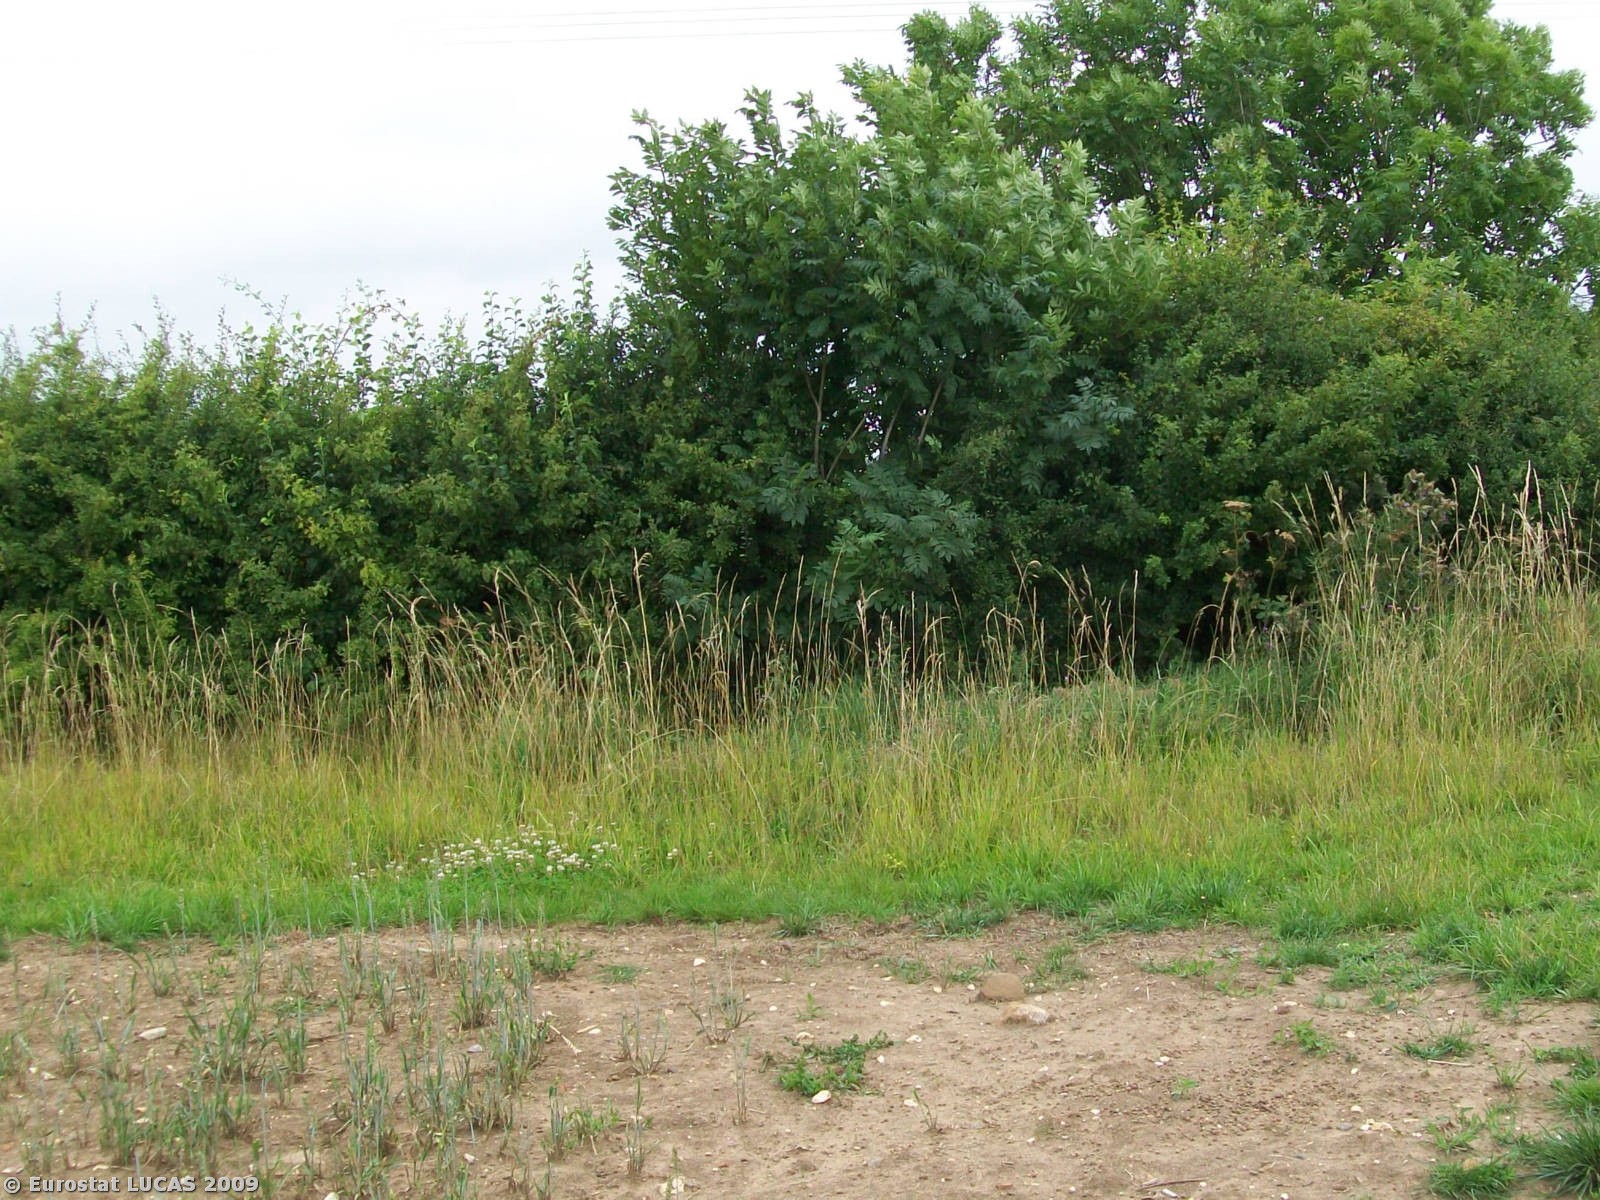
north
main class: Cropland
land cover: Common wheat
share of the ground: > 75 %
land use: Agriculture (excluding fallow land and kitchen gardens)
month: July
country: GB
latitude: 53.8706
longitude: -0.2694
